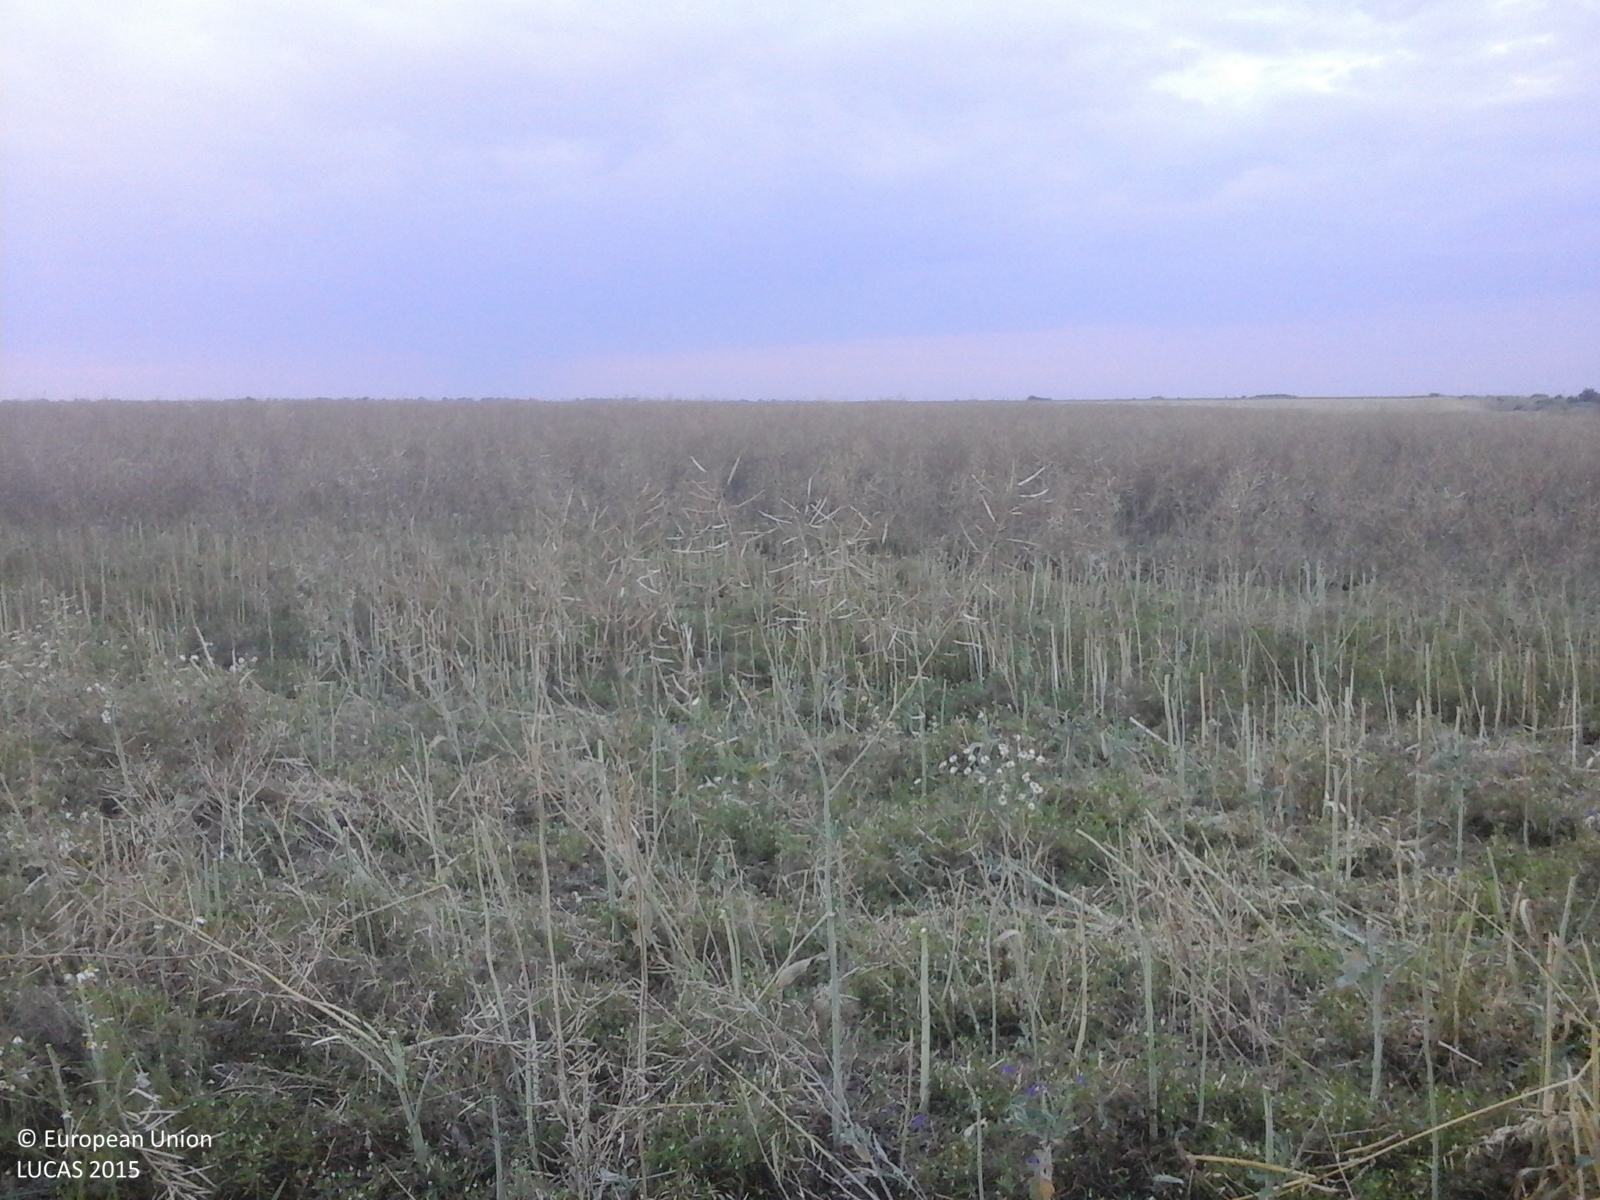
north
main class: Cropland
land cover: Rape and turnip rape
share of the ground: < 10 %
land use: Agriculture (excluding fallow land and kitchen gardens)
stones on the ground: < 10 %
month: June
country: RO
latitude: 44.1653
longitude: 26.4559
